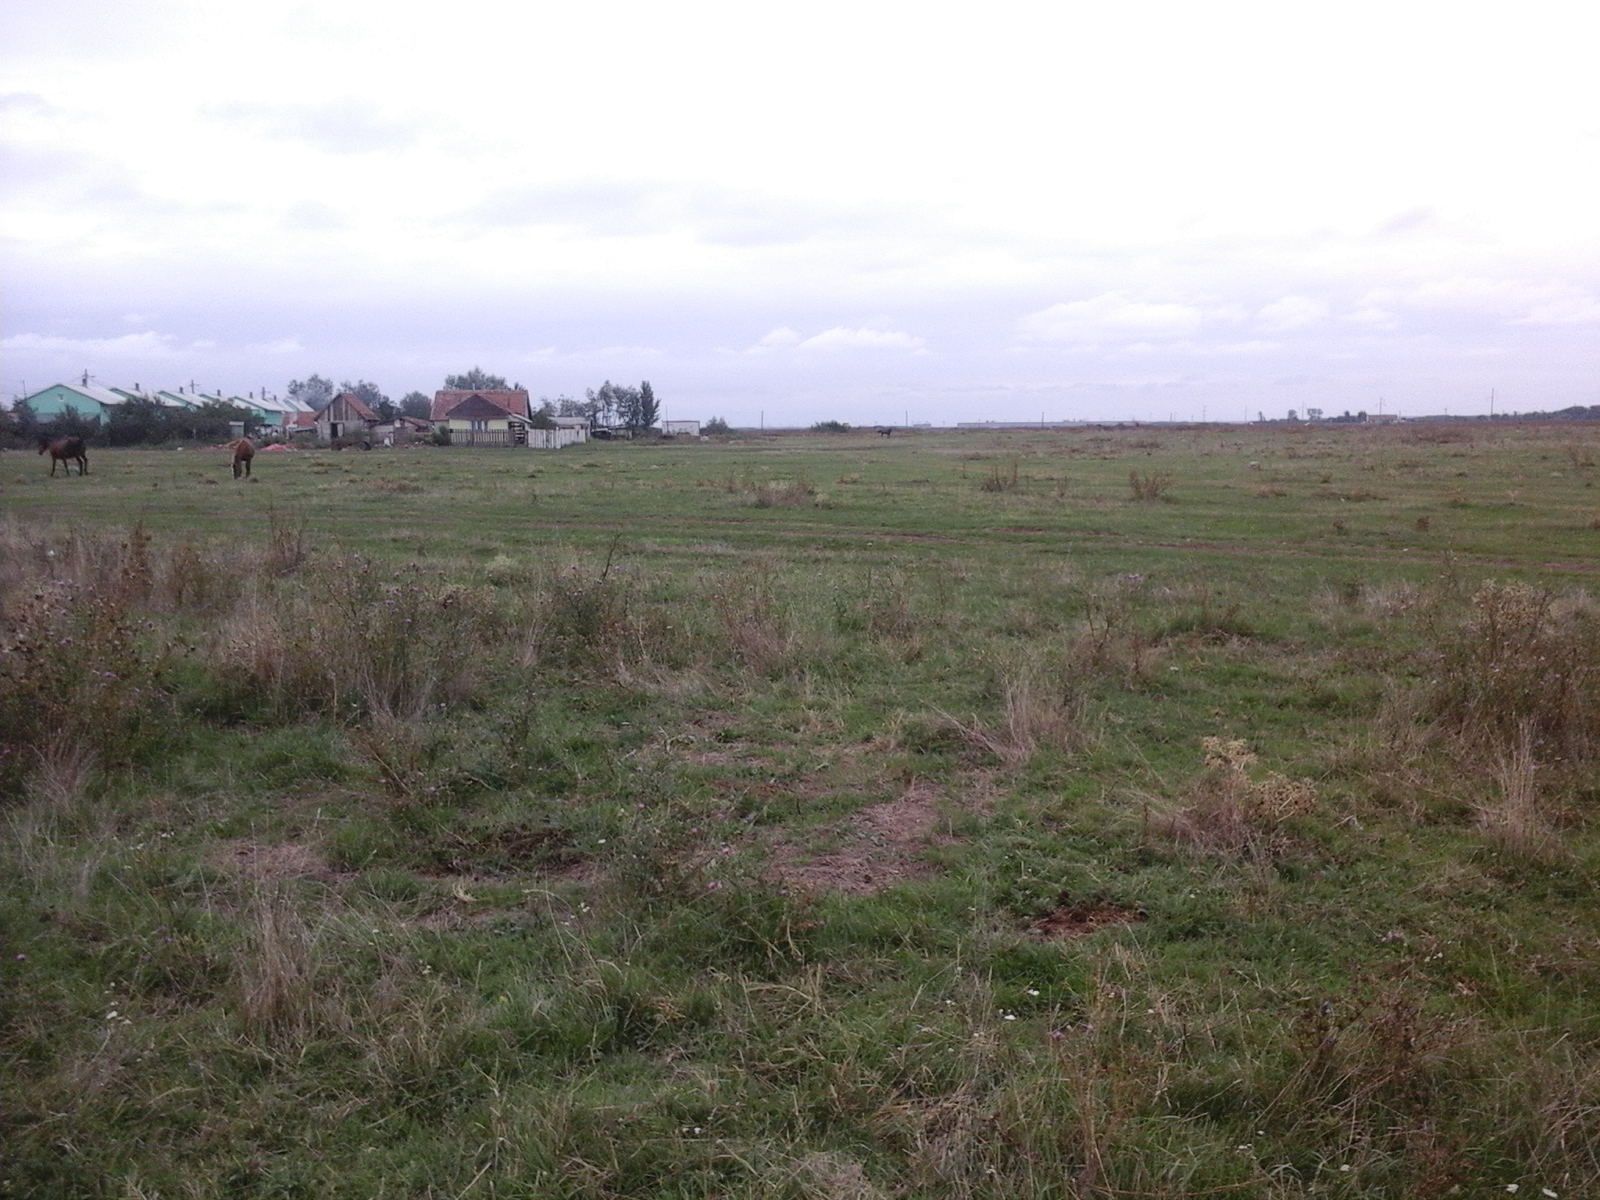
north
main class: Grassland
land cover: Spontaneously vegetated surfaces
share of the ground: > 75 %
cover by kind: herbaceous plants 100 %
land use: Agriculture (excluding fallow land and kitchen gardens)
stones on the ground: < 10 %
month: September
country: RO
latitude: 47.1547
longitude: 21.9303
